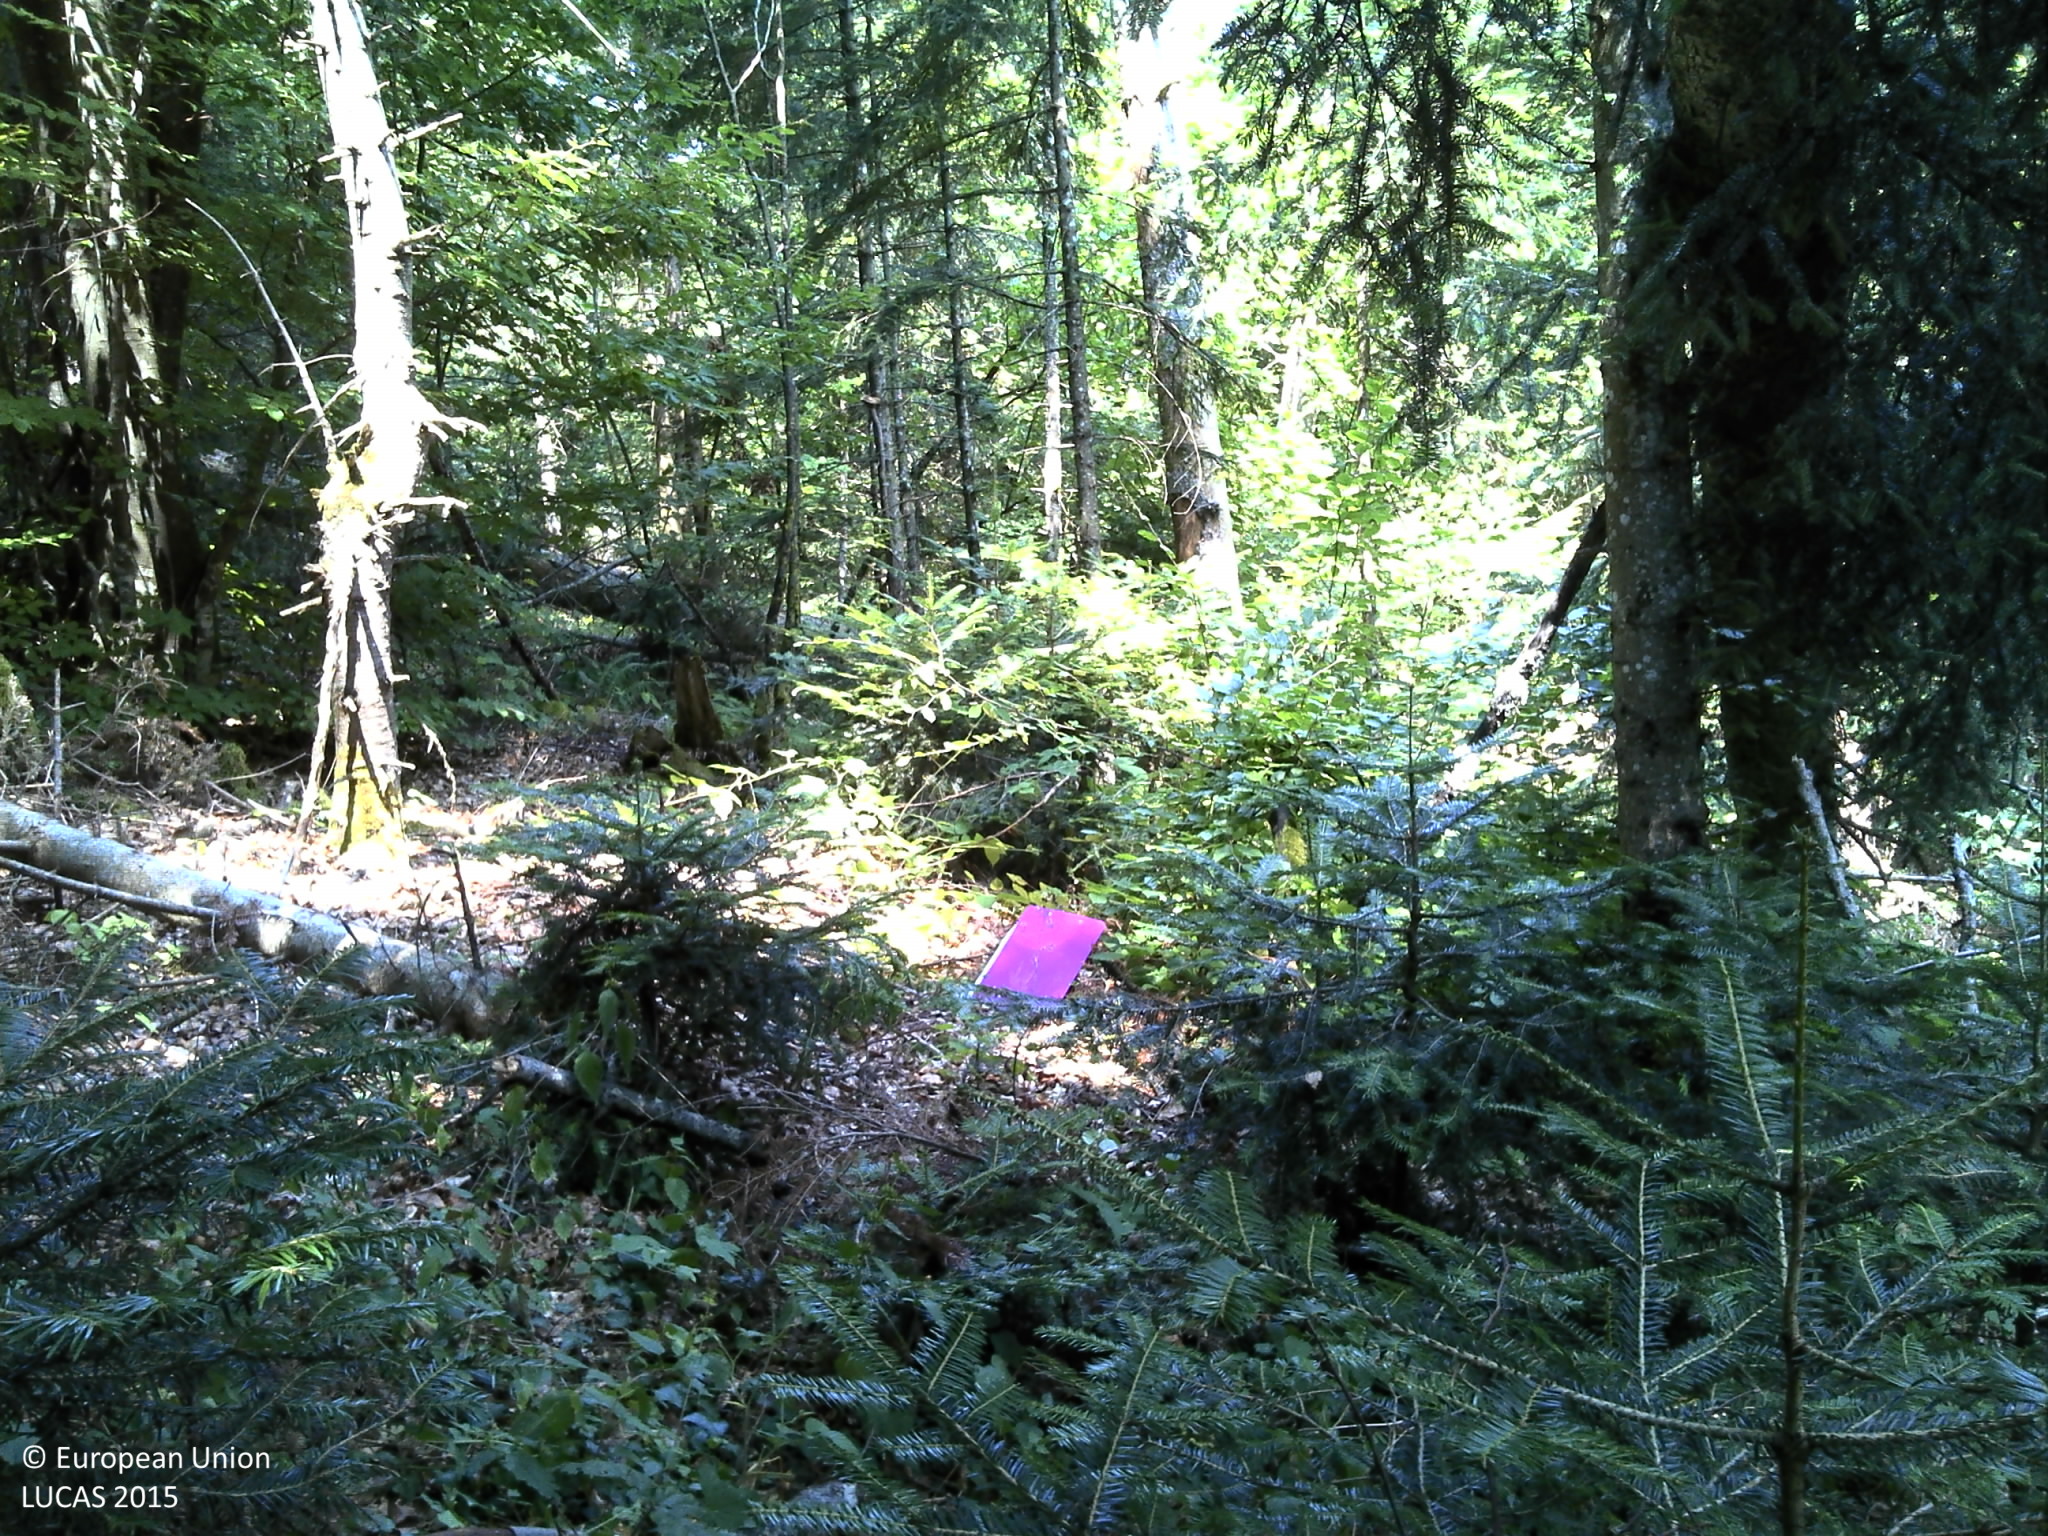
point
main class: Woodland
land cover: Spruce dominated mixed woodland
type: alpine coniferous forest
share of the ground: > 75 %
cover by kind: coniferous forest trees 50 %, broadleaved forest trees 30 %, shrubs 10 %, lichens and mosses 5 %, consolidated bare surface 5 %
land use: Forestry
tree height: > 5 m
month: July
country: HR
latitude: 45.0134
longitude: 15.2351
